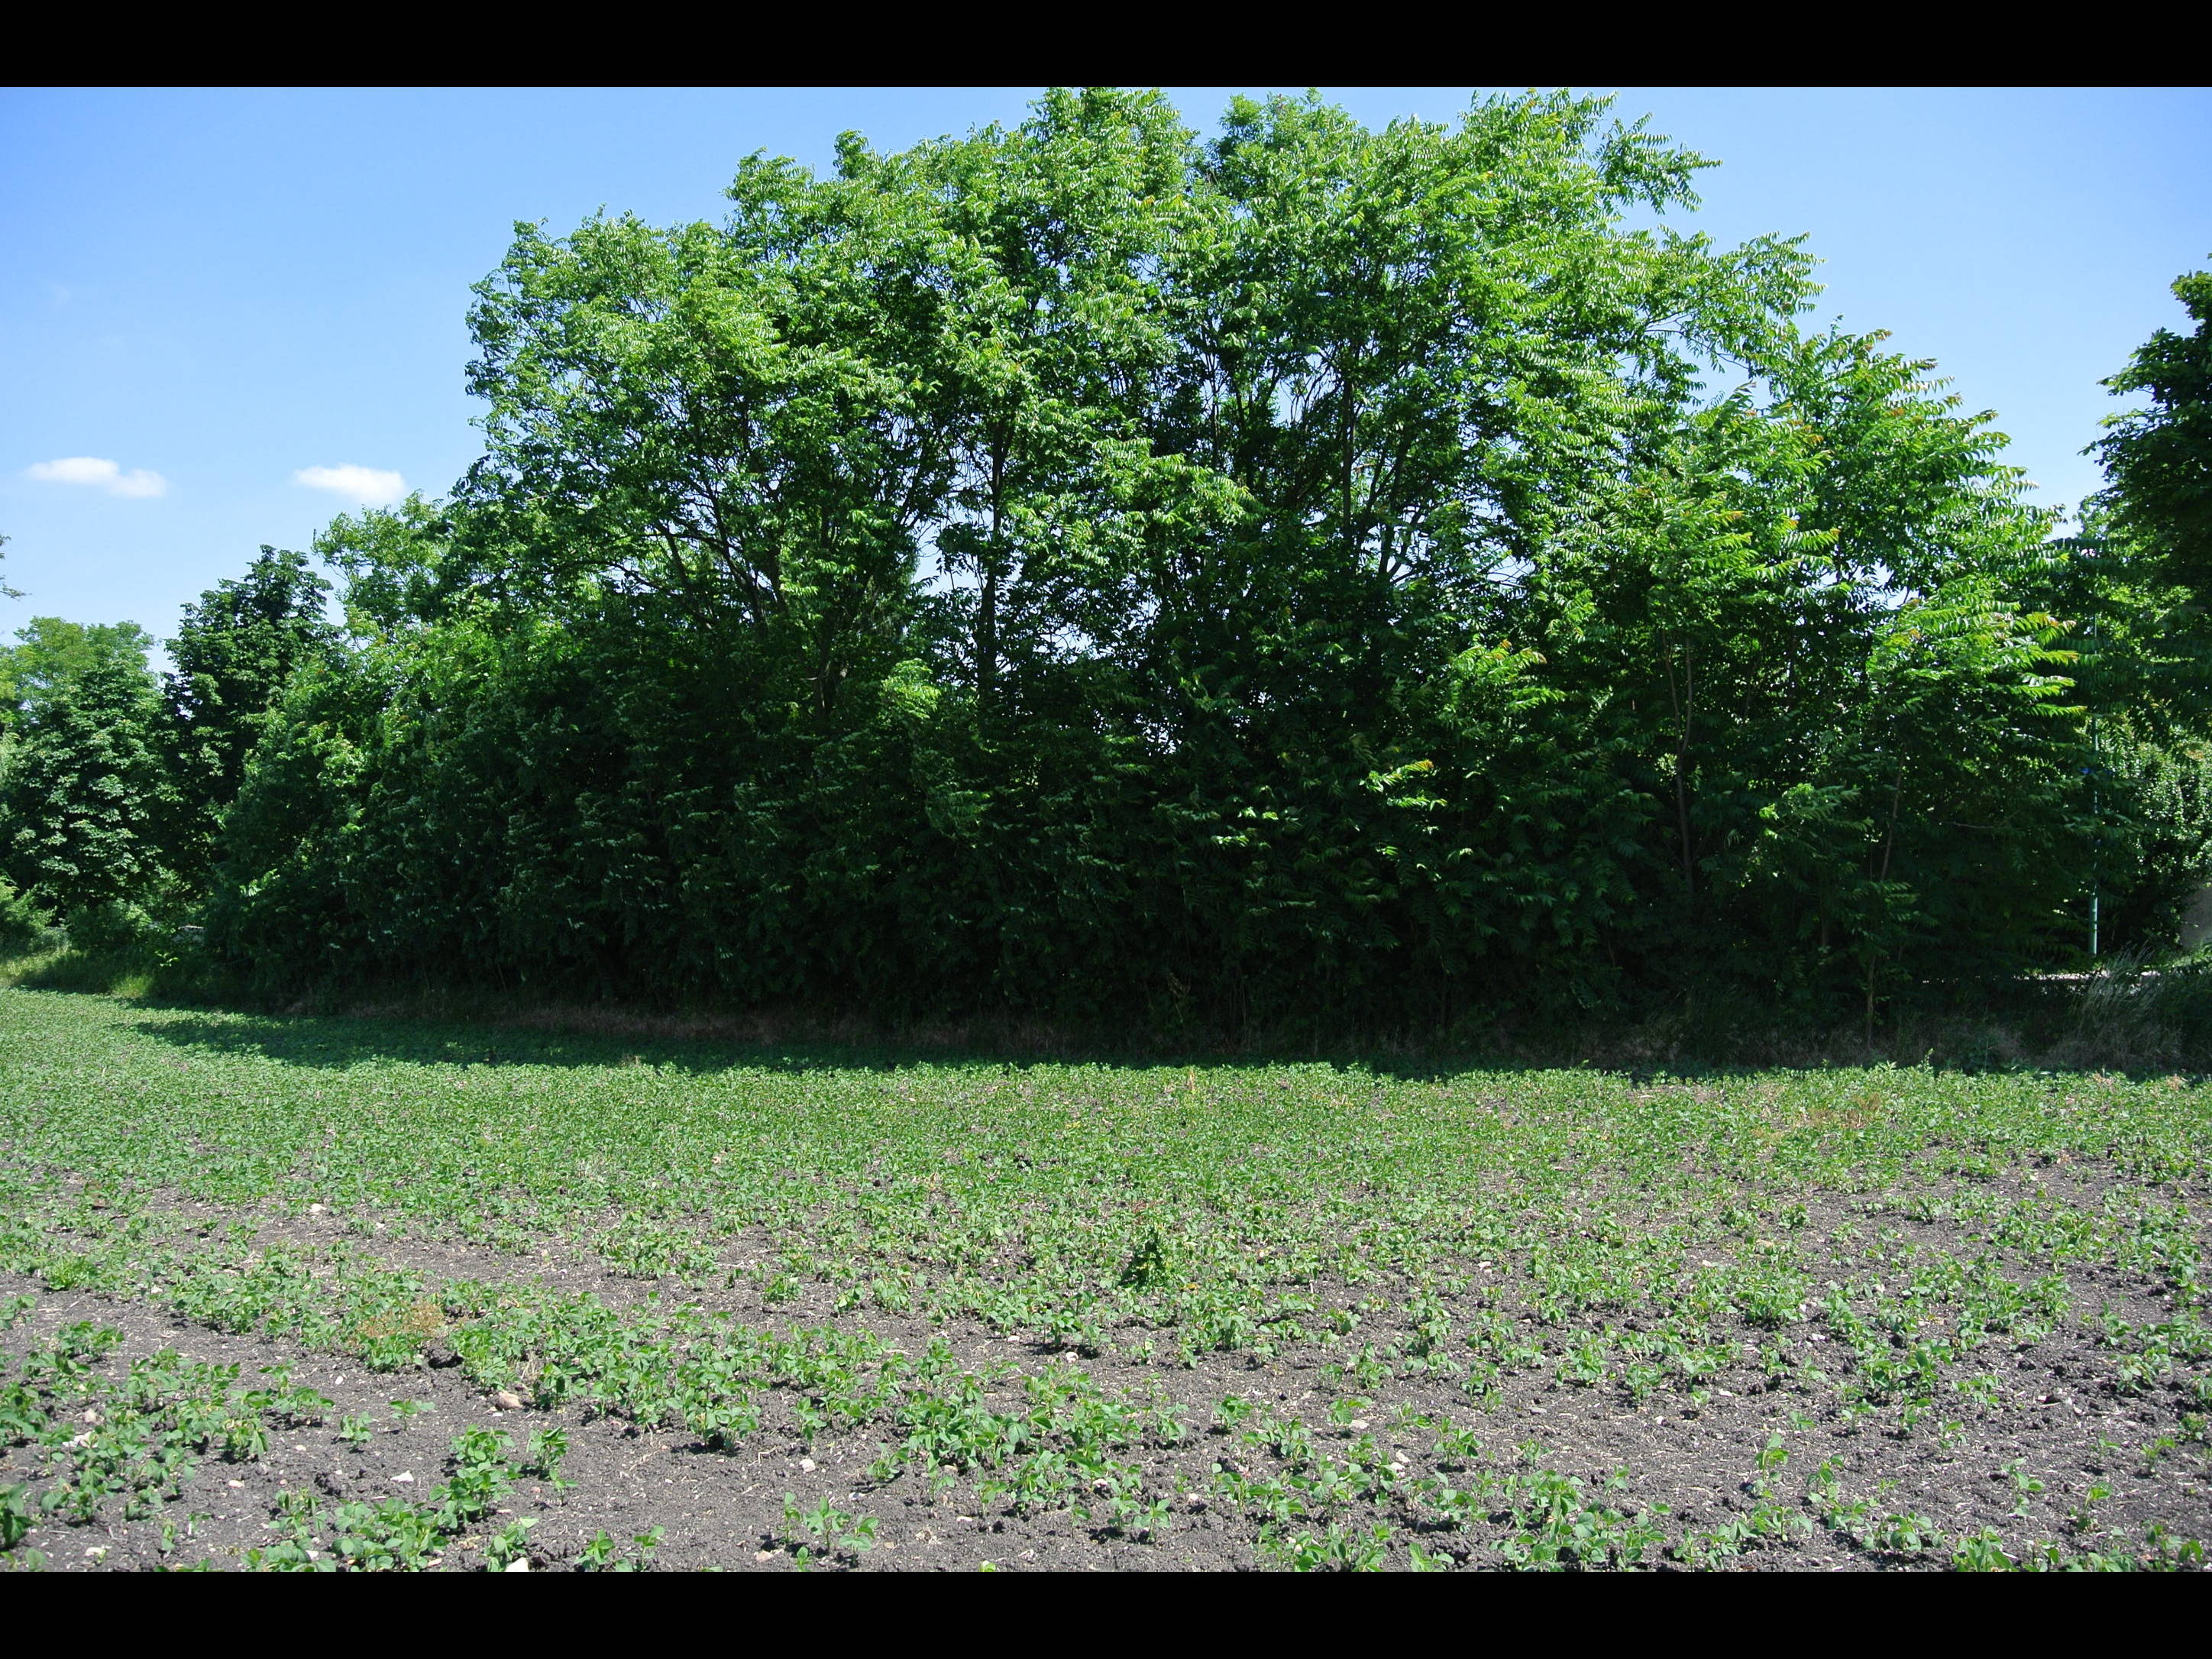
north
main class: Cropland
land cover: Soya
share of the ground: > 75 %
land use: Agriculture (excluding fallow land and kitchen gardens)
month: June
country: AT
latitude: 47.7818
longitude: 16.4507
